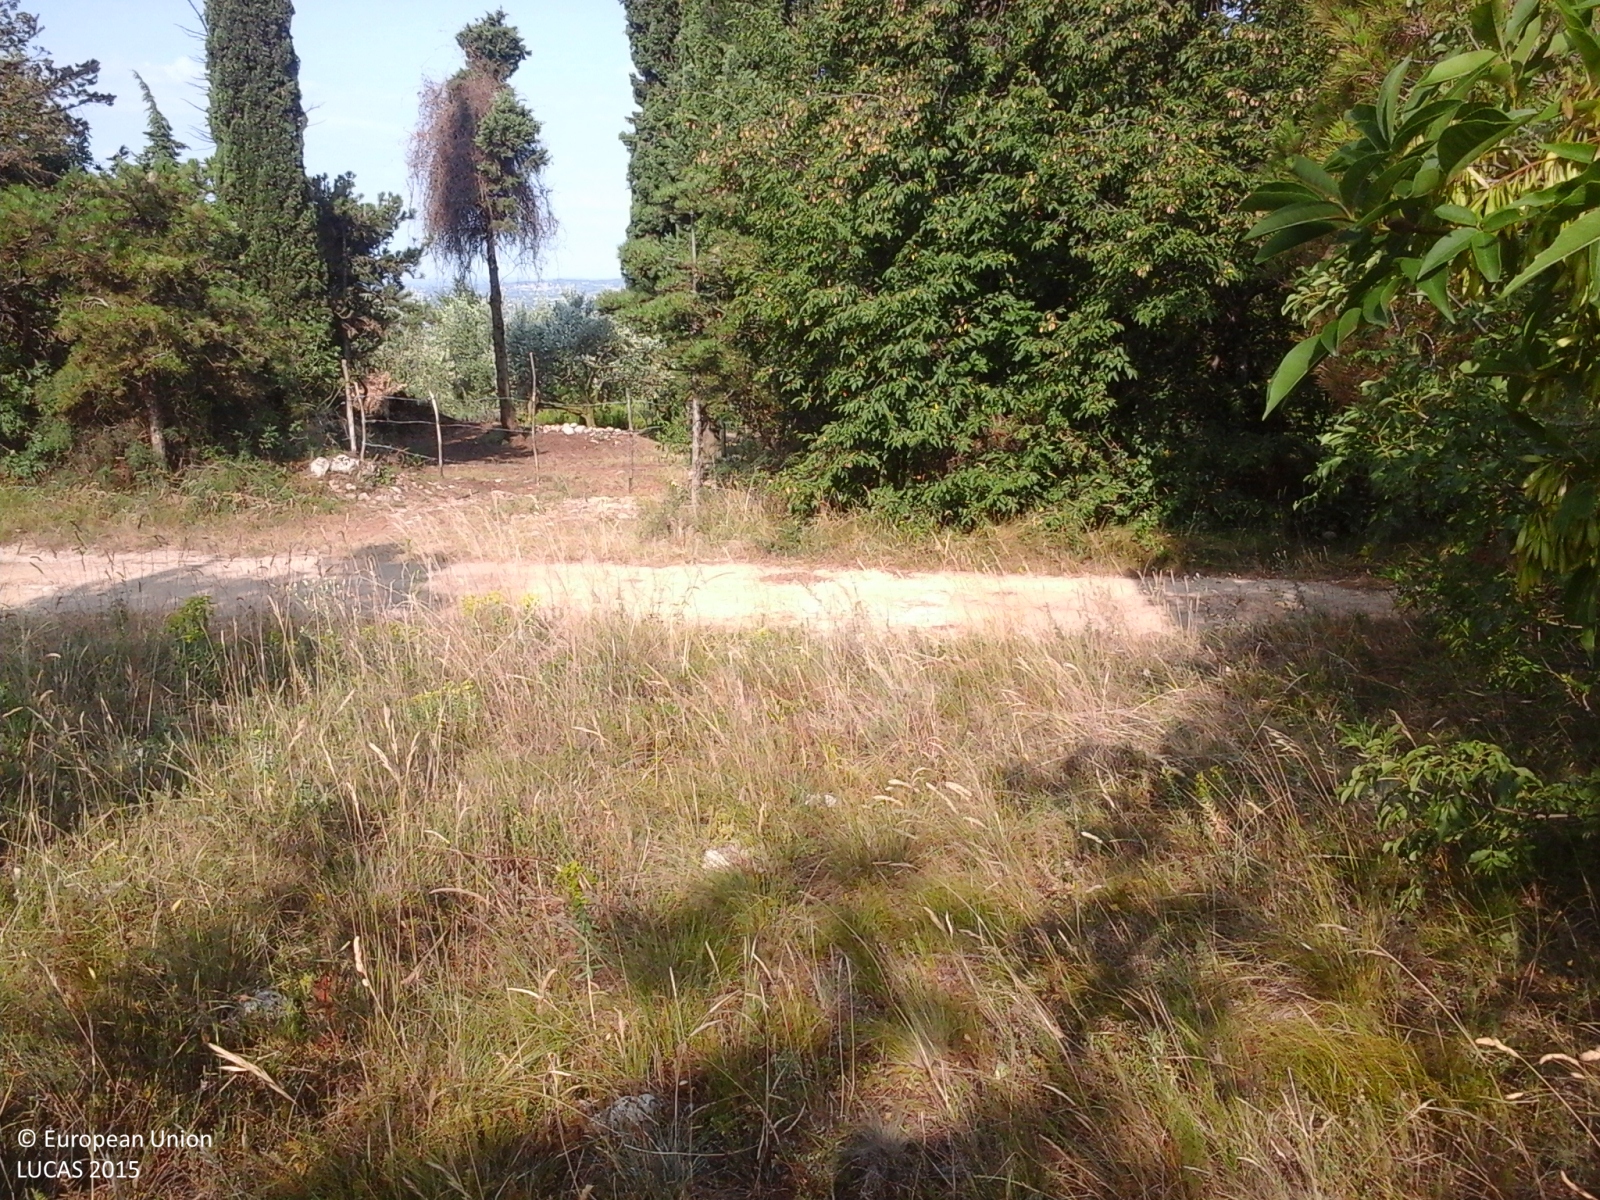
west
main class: Grassland
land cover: Grassland with sparse tree/shrub cover
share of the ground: > 75 %
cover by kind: herbaceous plants 85 %, shrubs 10 %, broadleaved forest trees 5 %
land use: Agriculture (excluding fallow land and kitchen gardens)
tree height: < 5 m
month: July
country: IT
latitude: 45.4818
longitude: 10.9834
